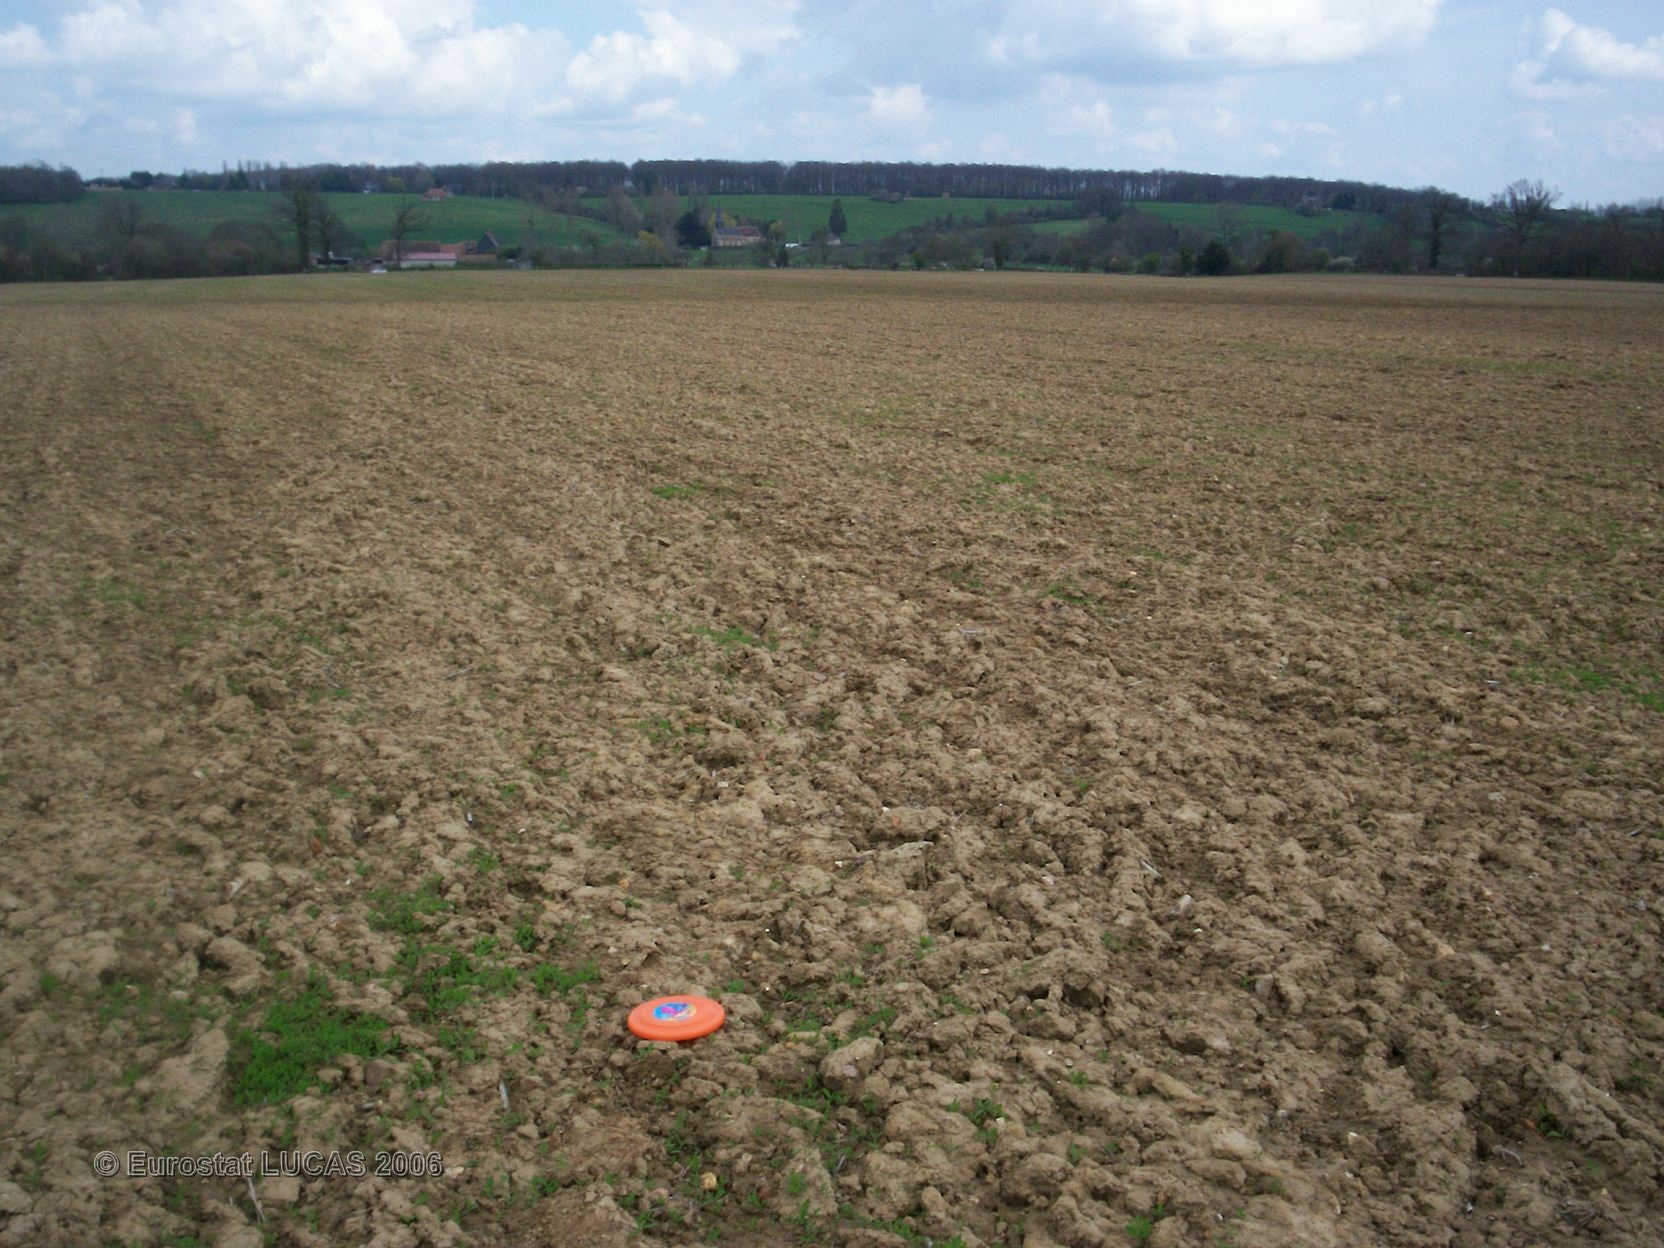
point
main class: Cropland
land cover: Maize
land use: Agriculture (excluding fallow land and kitchen gardens)
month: April
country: FR
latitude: 49.0591
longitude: 0.0480
